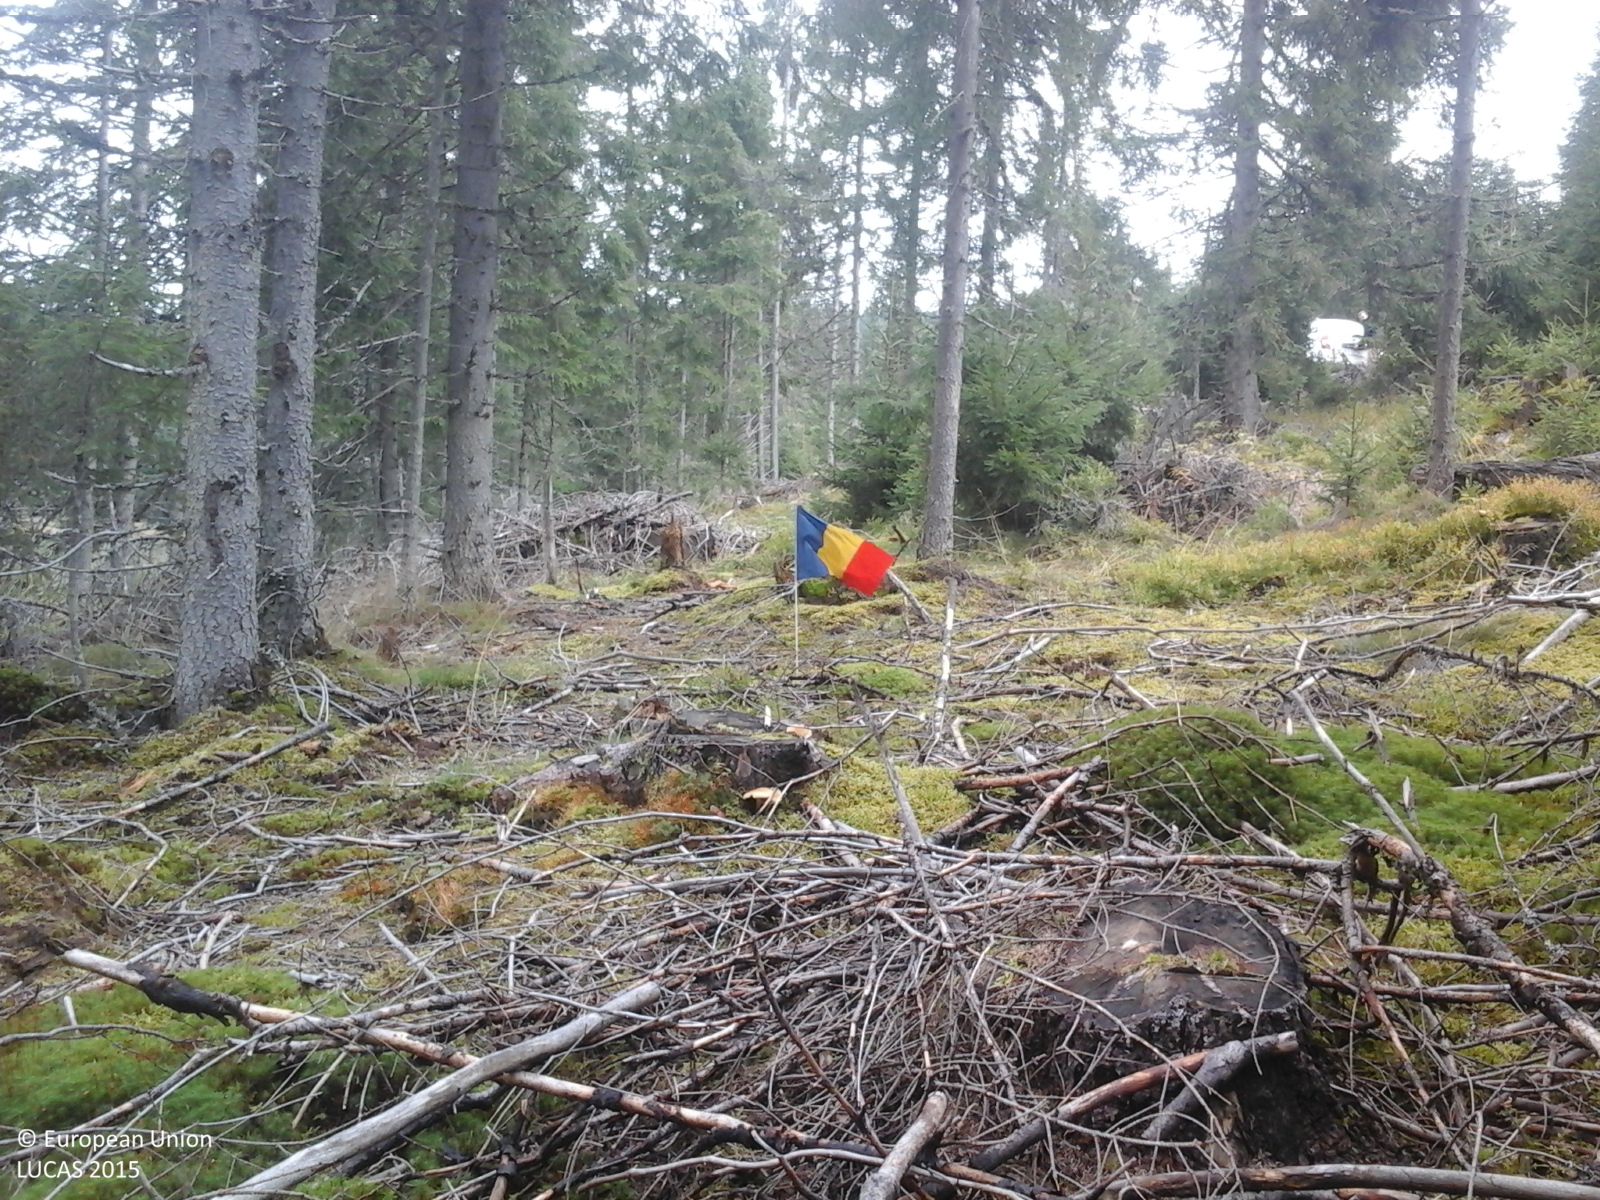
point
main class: Woodland
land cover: Spruce dominated coniferous woodland
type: alpine coniferous forest
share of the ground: > 75 %
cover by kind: coniferous forest trees 100 %
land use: Forestry
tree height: > 5 m
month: September
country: RO
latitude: 46.5344
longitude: 23.0333
